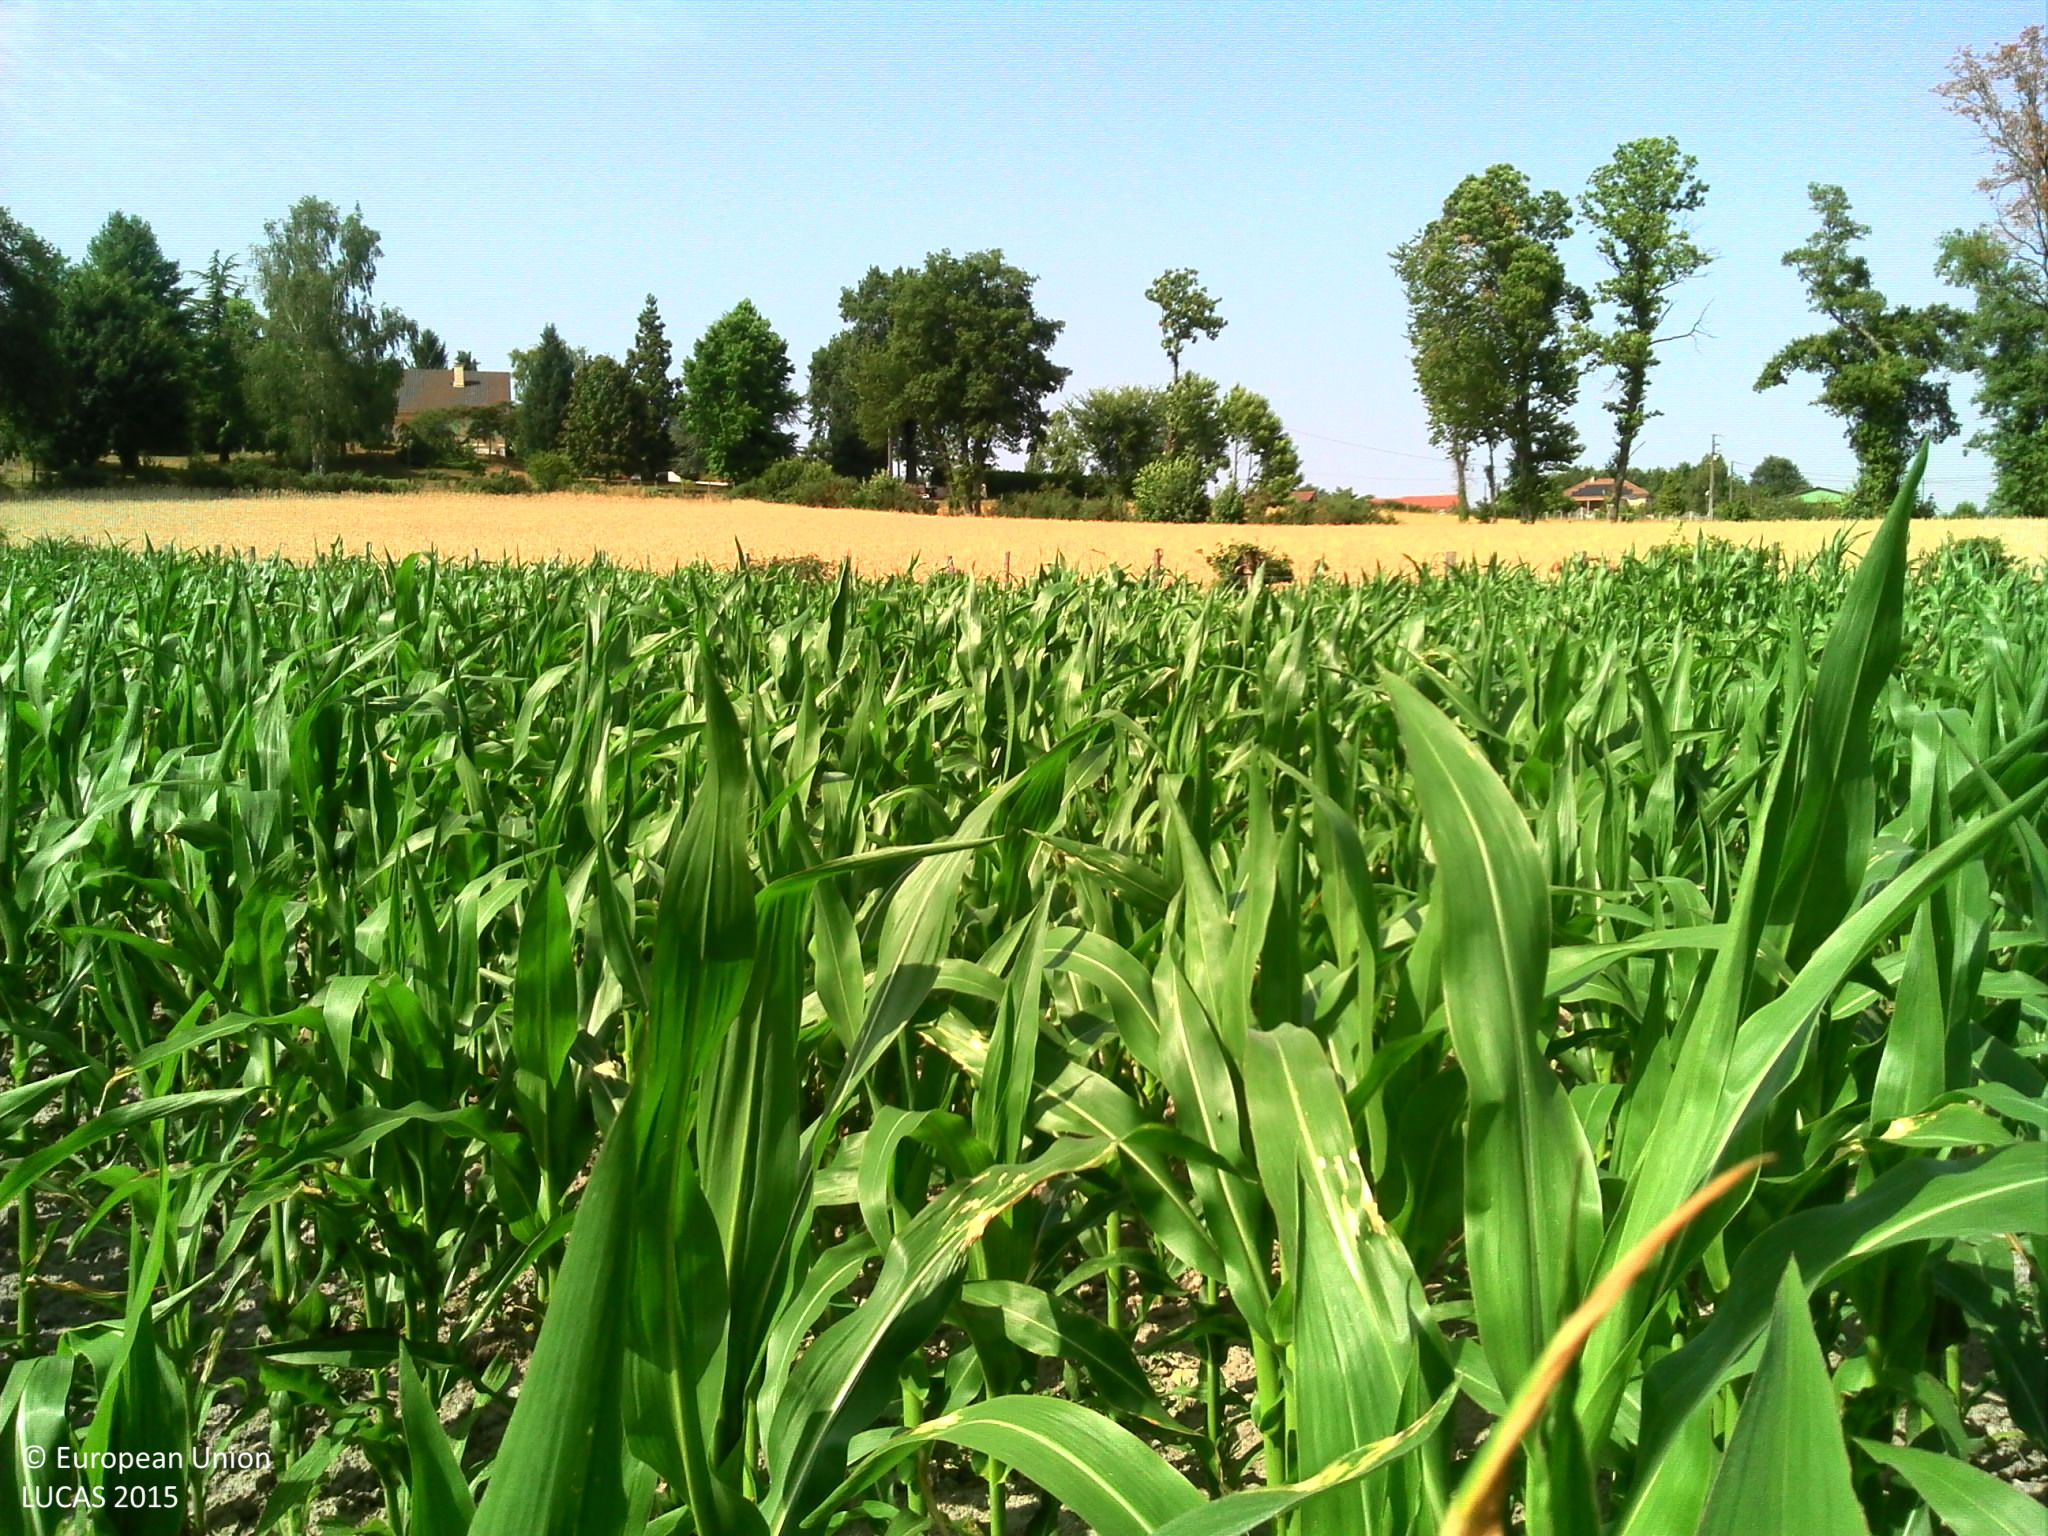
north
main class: Cropland
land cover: Maize
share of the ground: > 75 %
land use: Agriculture (excluding fallow land and kitchen gardens)
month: July
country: FR
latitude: 45.7762
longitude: 1.0515
